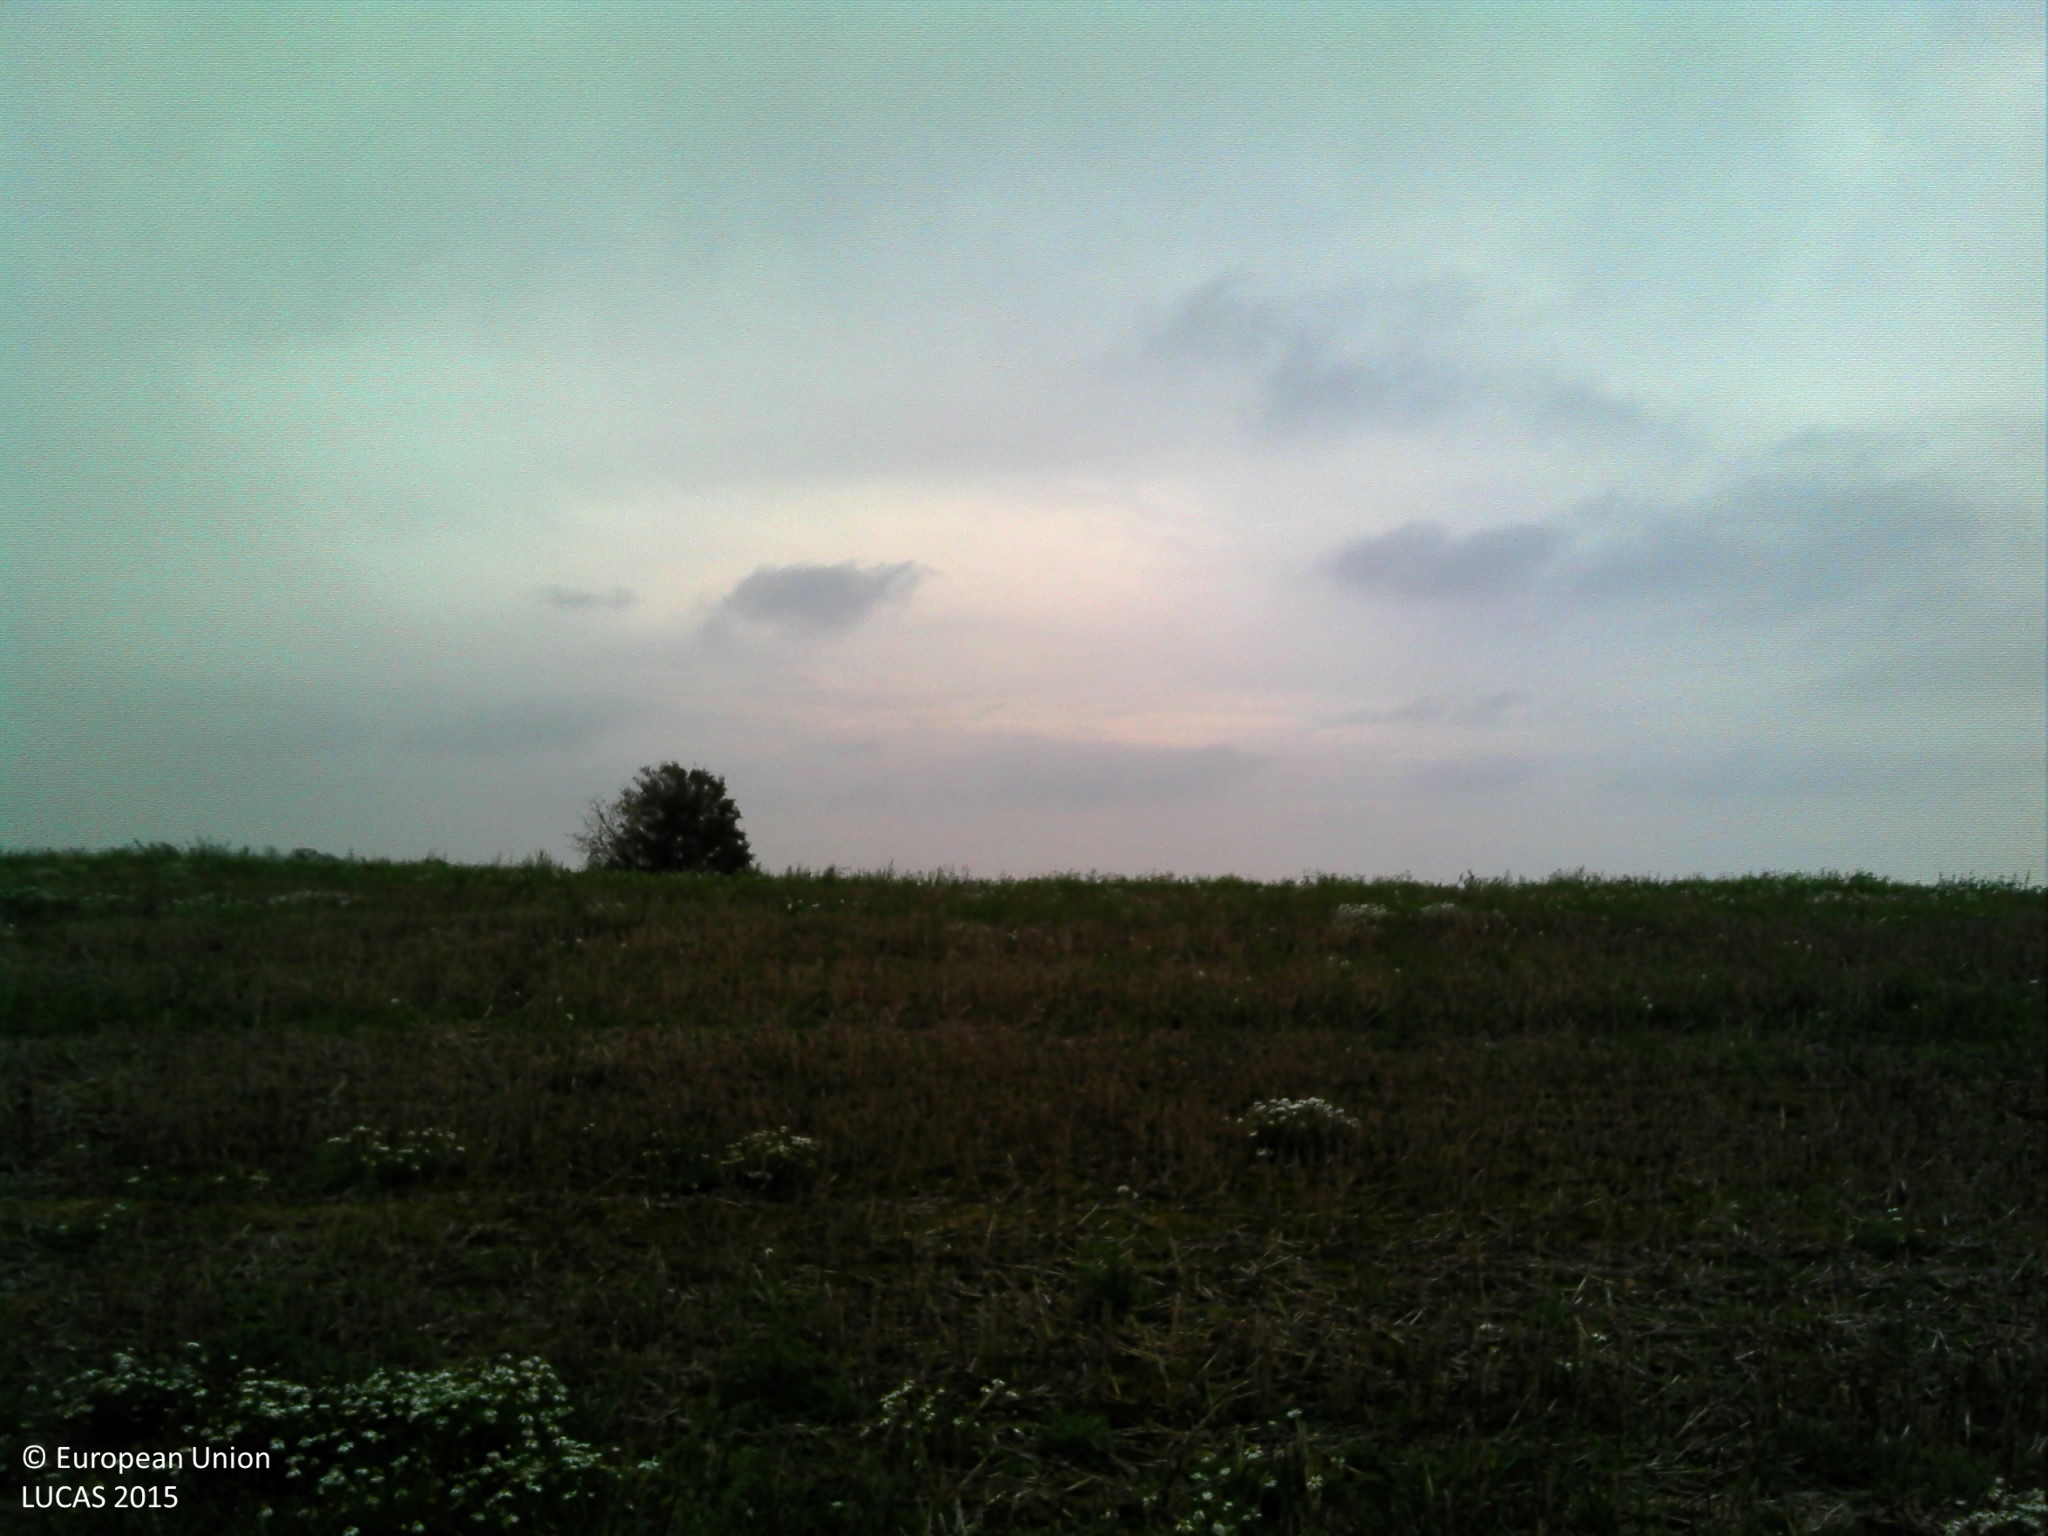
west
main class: Cropland
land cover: Common wheat
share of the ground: > 75 %
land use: Agriculture (excluding fallow land and kitchen gardens)
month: October
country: FR
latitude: 46.1568
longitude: 4.8878
